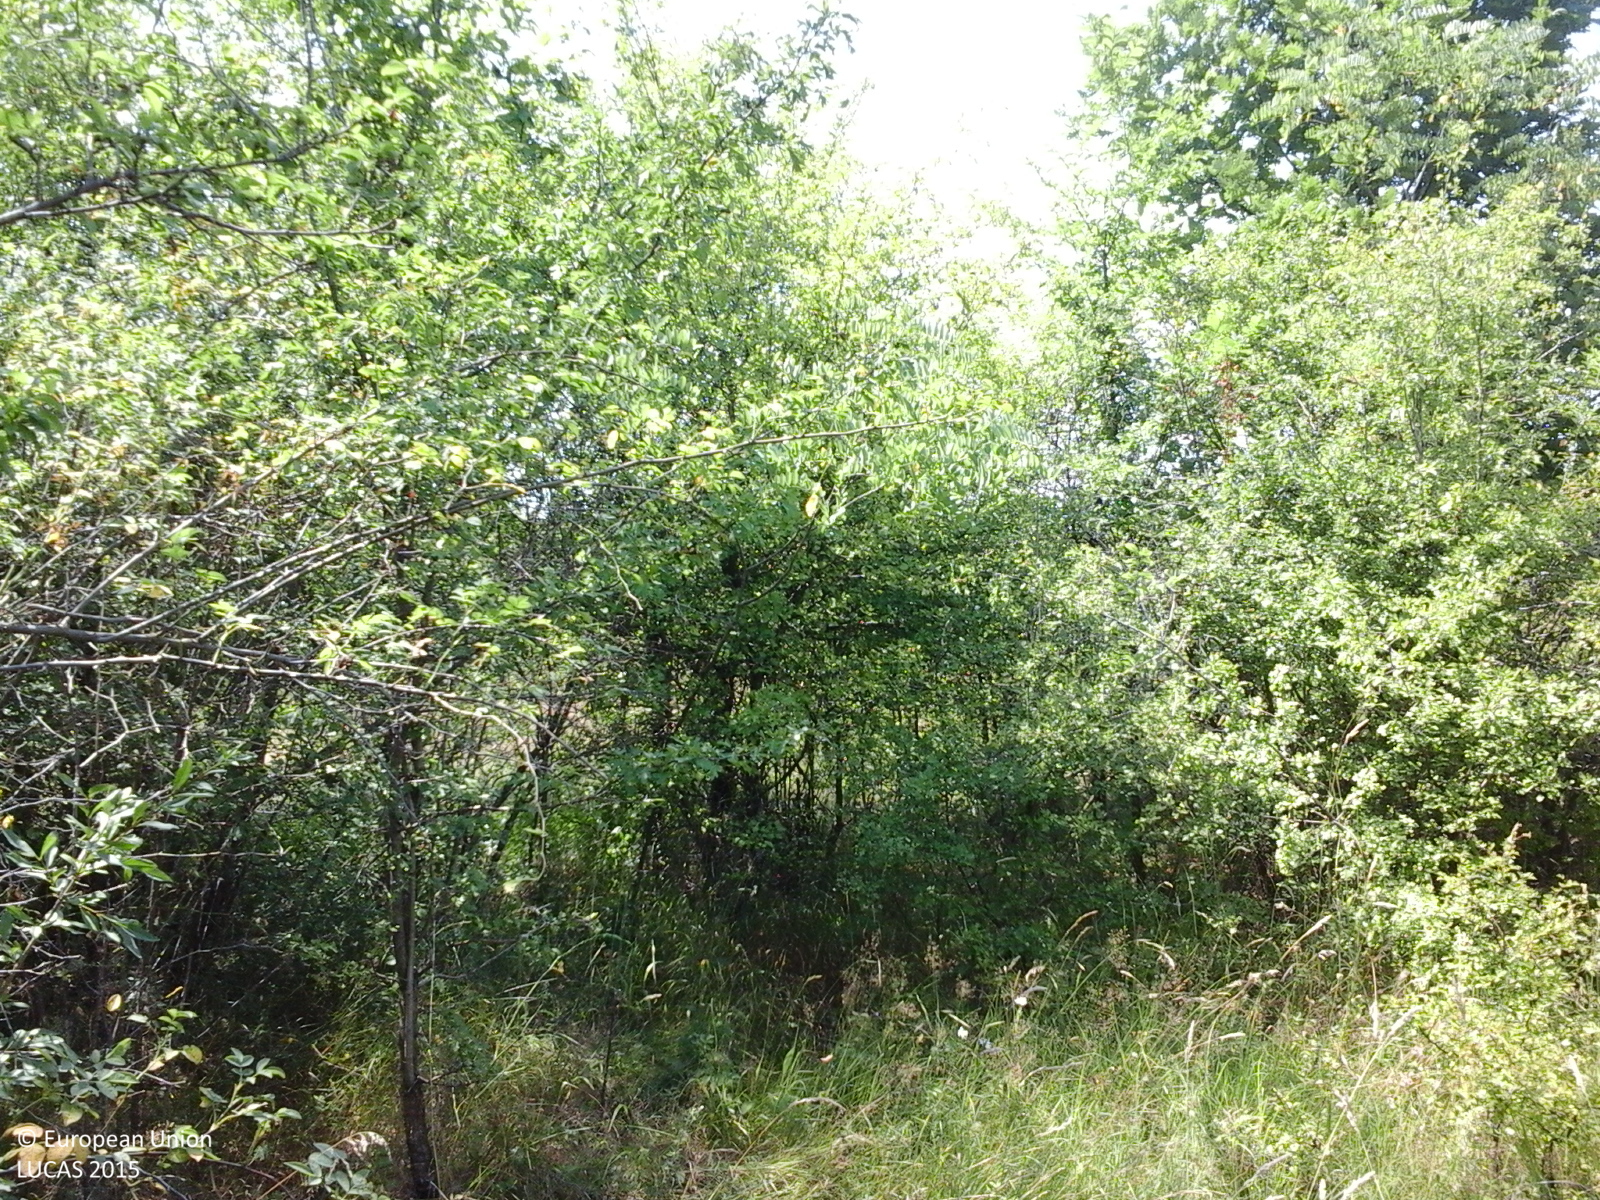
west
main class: Woodland
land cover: Broadleaved woodland
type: acidophilous oak and oak-birch forest
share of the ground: > 75 %
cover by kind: broadleaved forest trees 100 %
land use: Forestry
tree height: > 5 m
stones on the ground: < 10 %
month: July
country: RO
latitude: 44.7622
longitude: 24.5655
